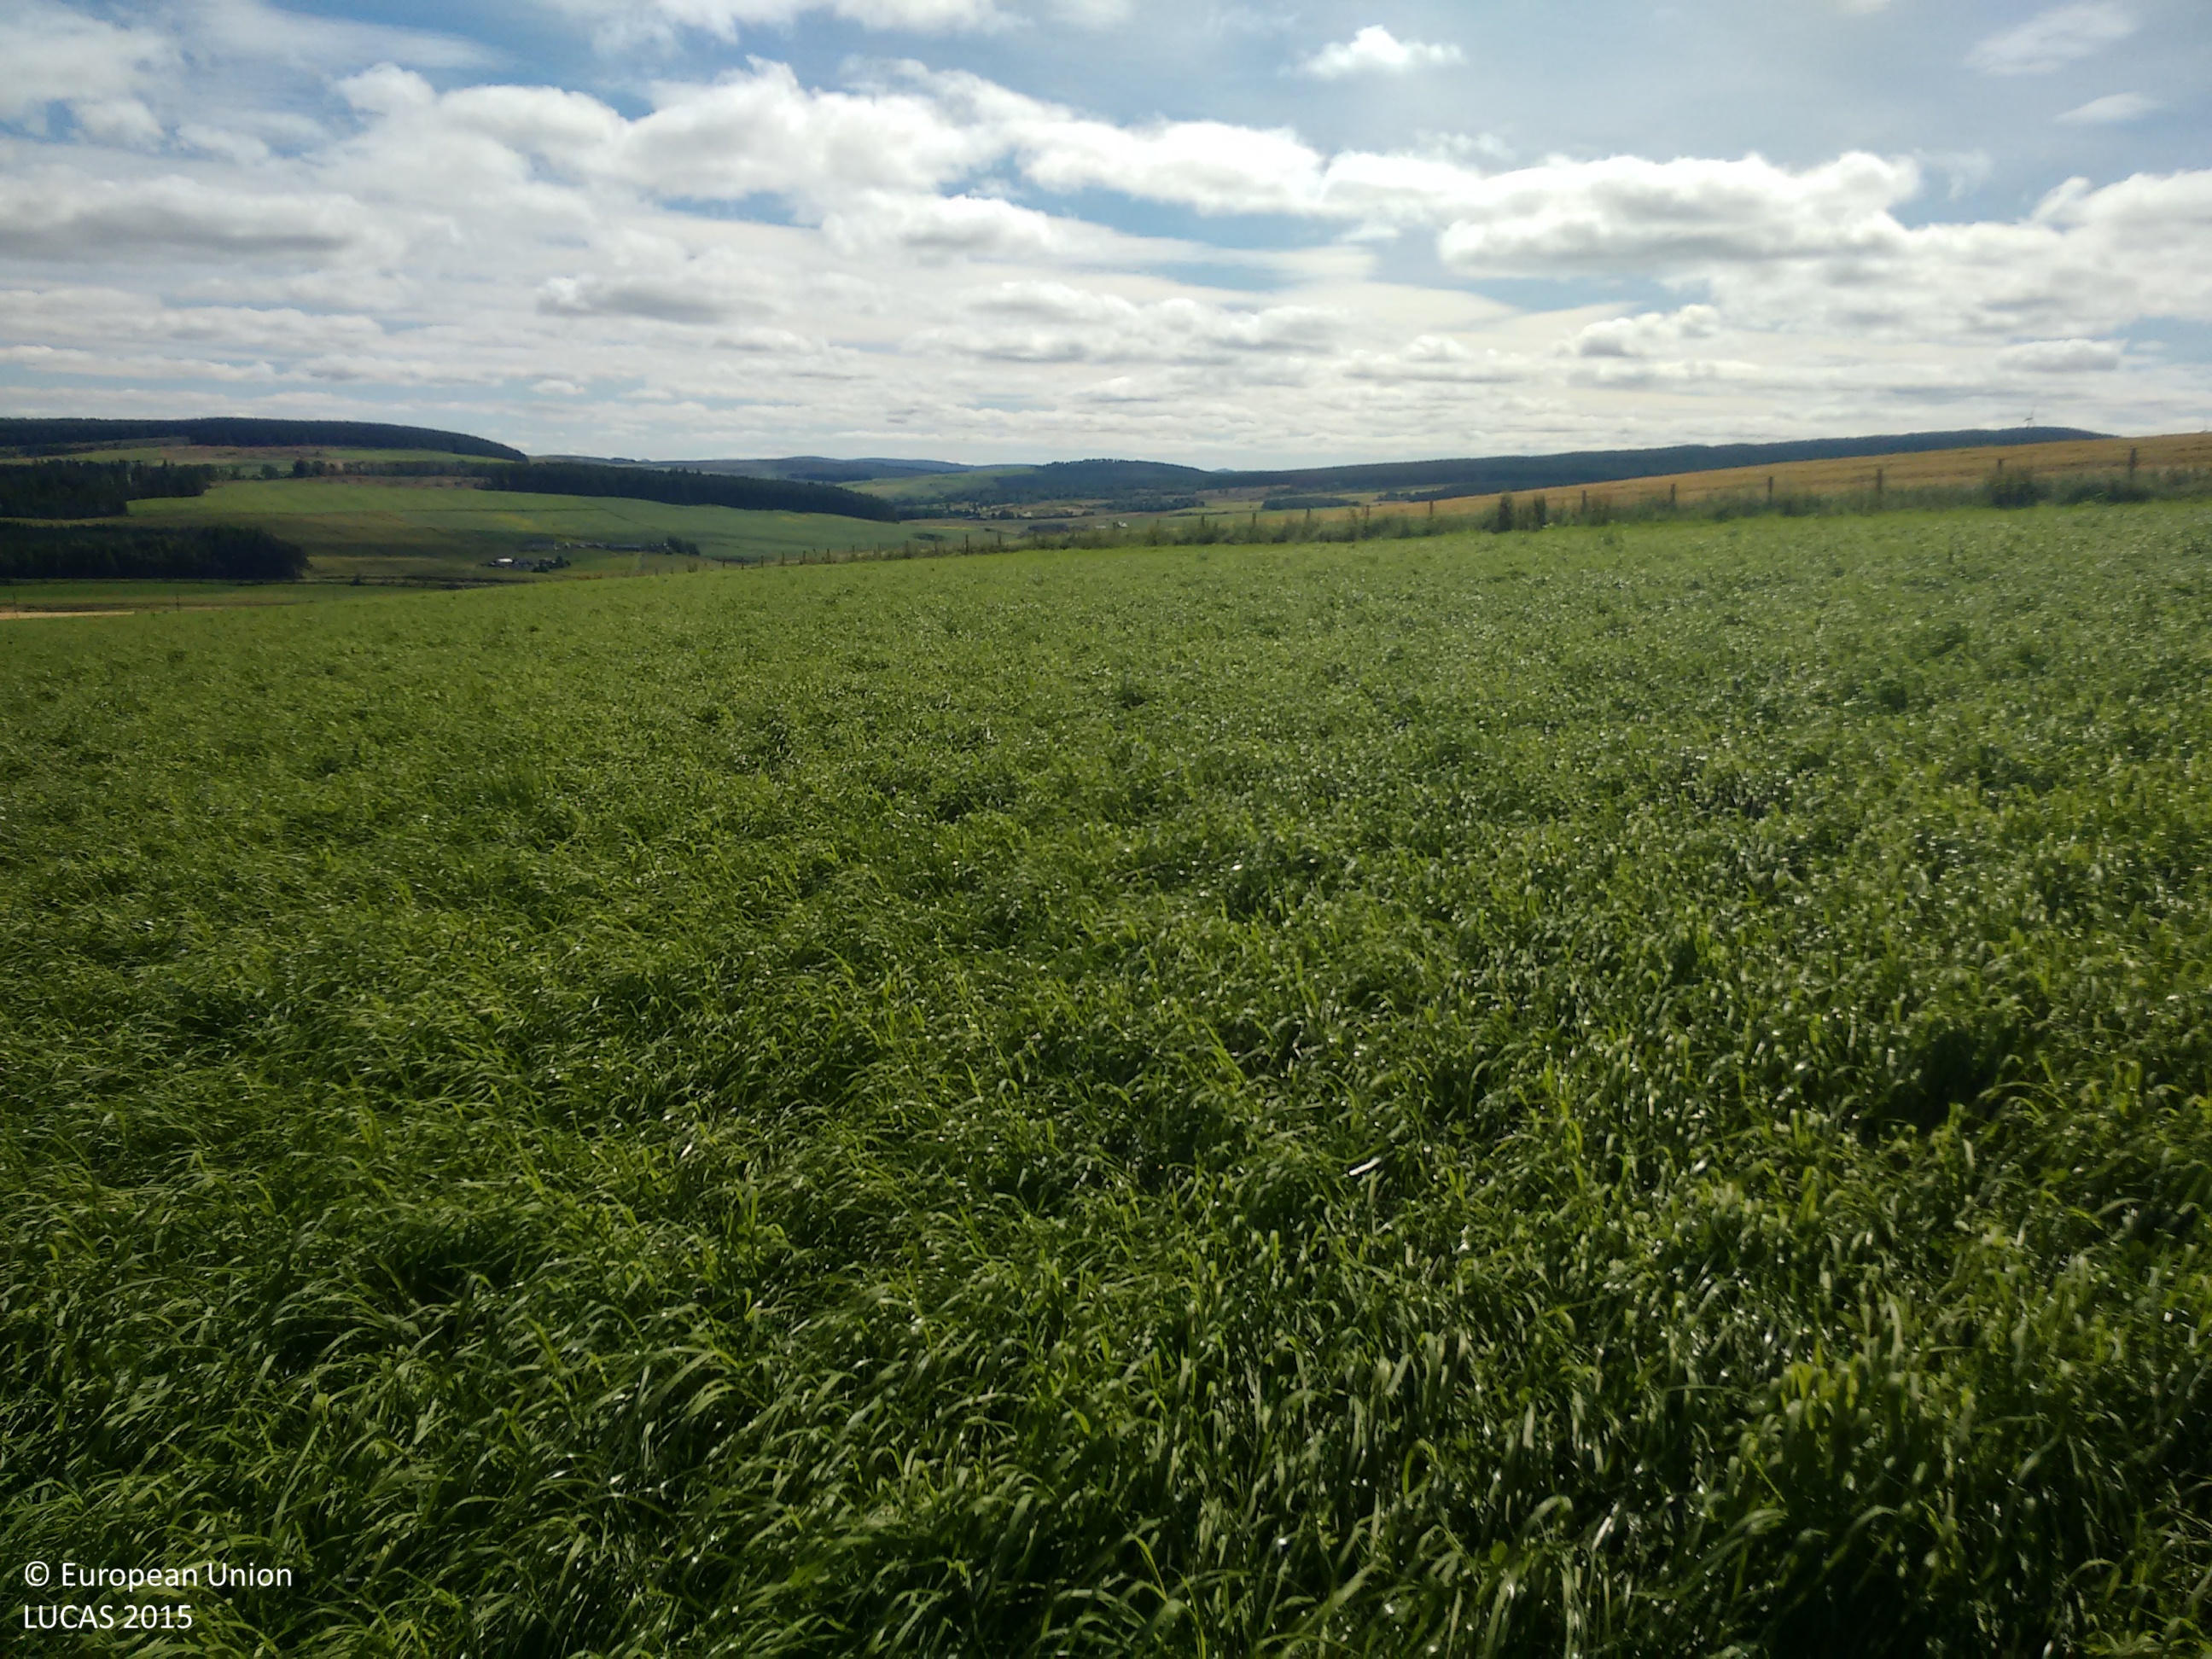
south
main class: Grassland
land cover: Grassland without tree/shrub cover
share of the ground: > 75 %
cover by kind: herbaceous plants 100 %
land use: Agriculture (excluding fallow land and kitchen gardens)
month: August
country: GB
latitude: 57.5470
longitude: -3.0104
